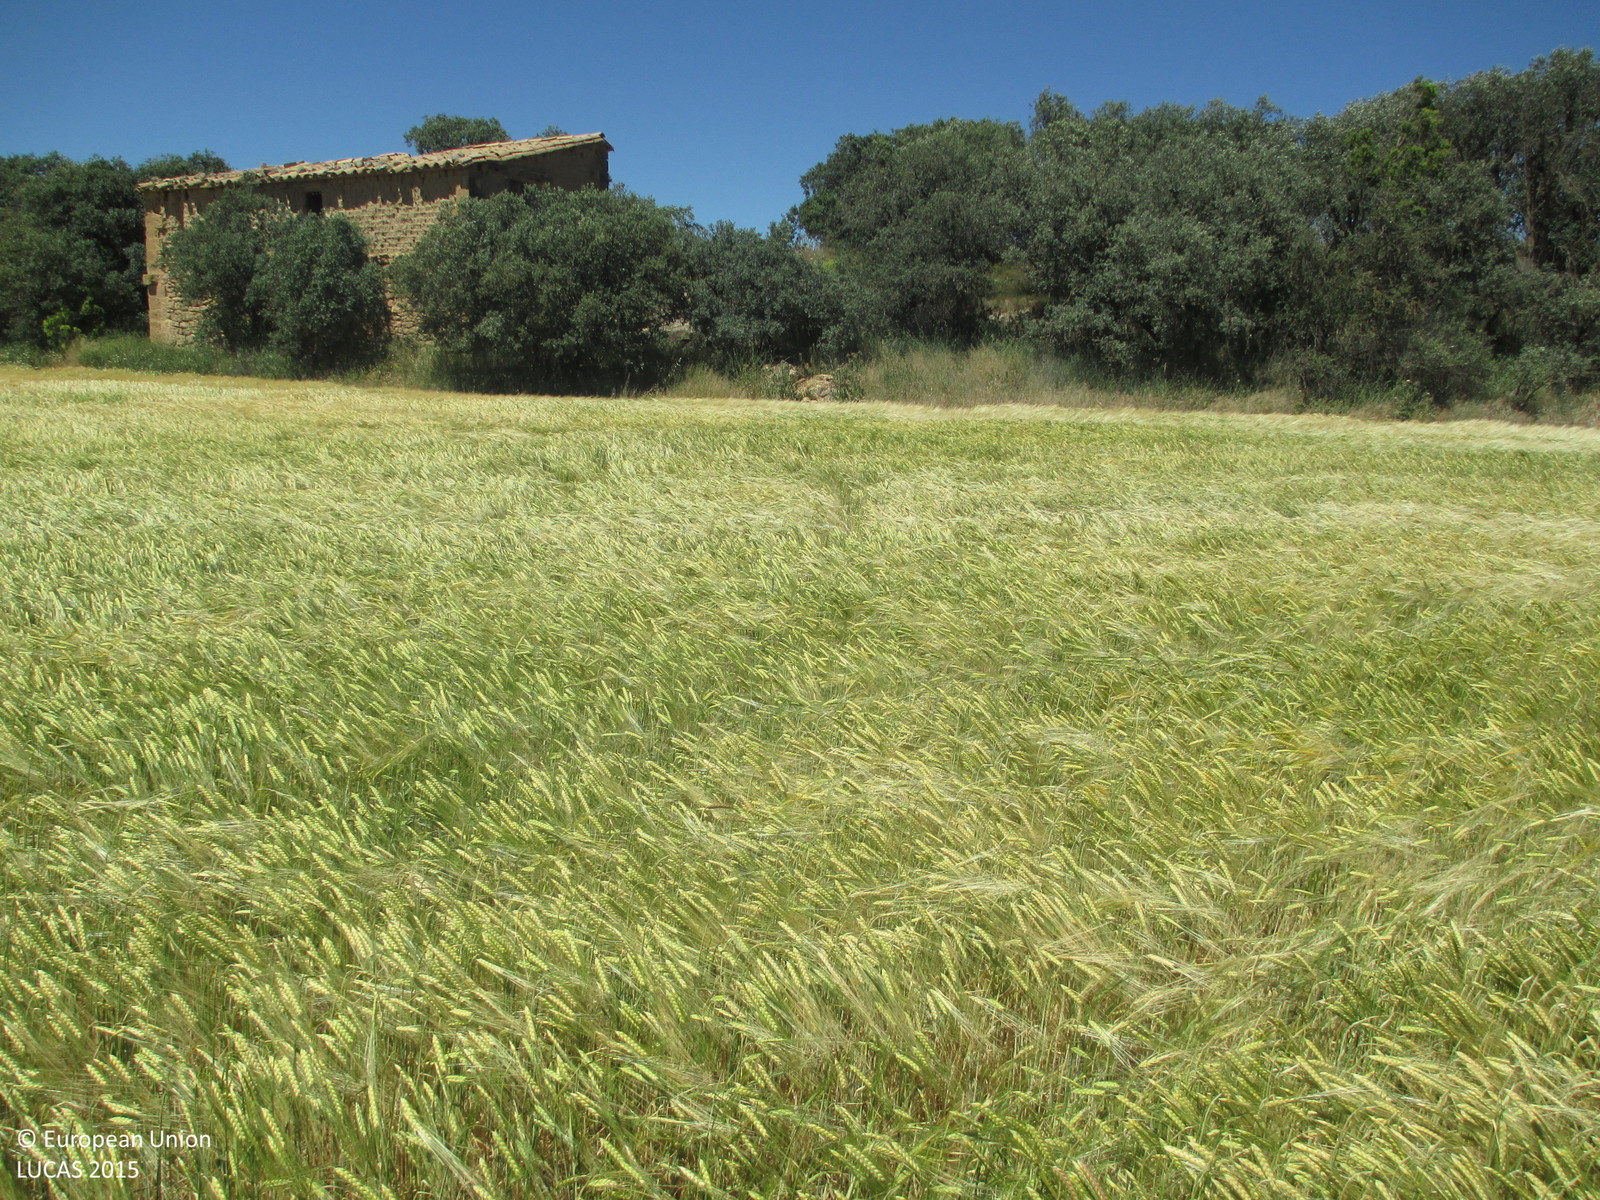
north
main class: Cropland
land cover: Barley
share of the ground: > 75 %
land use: Agriculture (excluding fallow land and kitchen gardens)
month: May
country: ES
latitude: 42.0284
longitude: -0.2021
